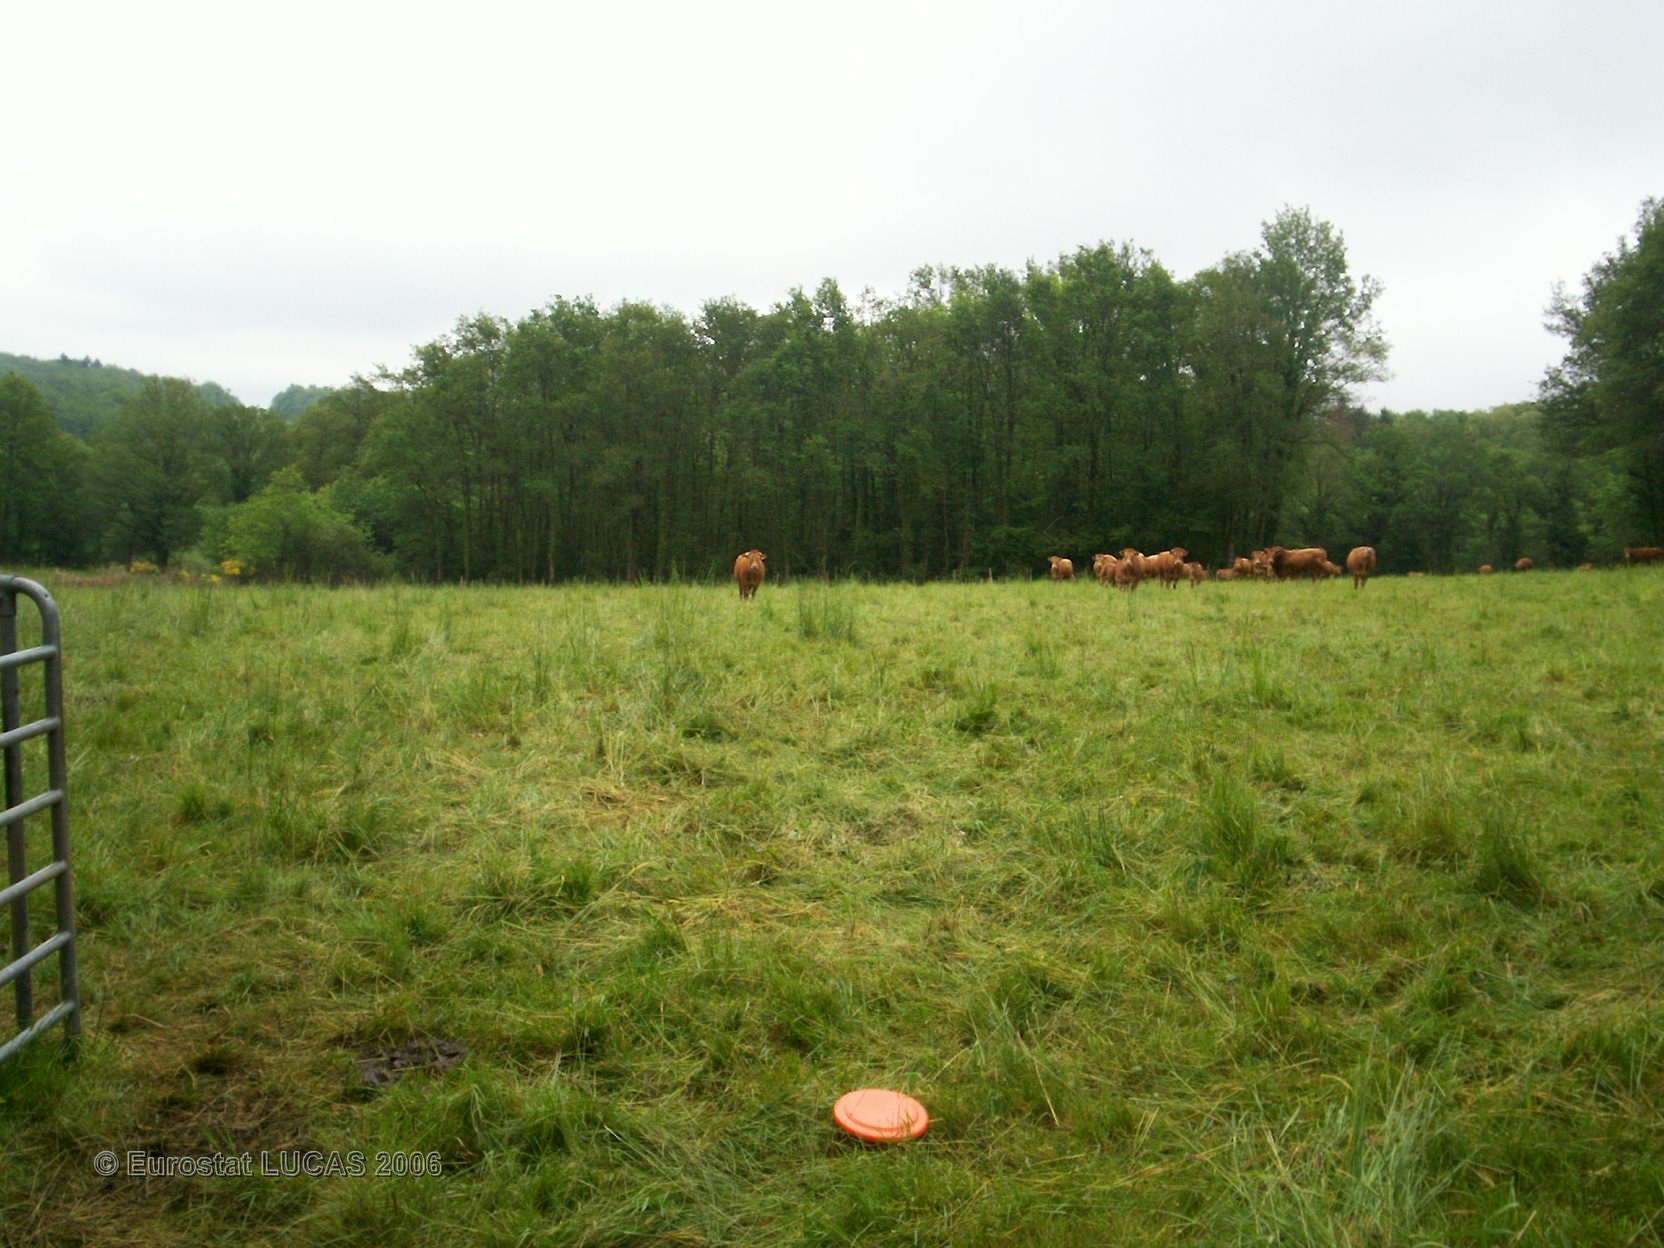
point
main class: Grassland
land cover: Grassland without tree/shrub cover
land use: Agriculture (excluding fallow land and kitchen gardens)
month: May
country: FR
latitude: 45.8056
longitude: 0.7616
